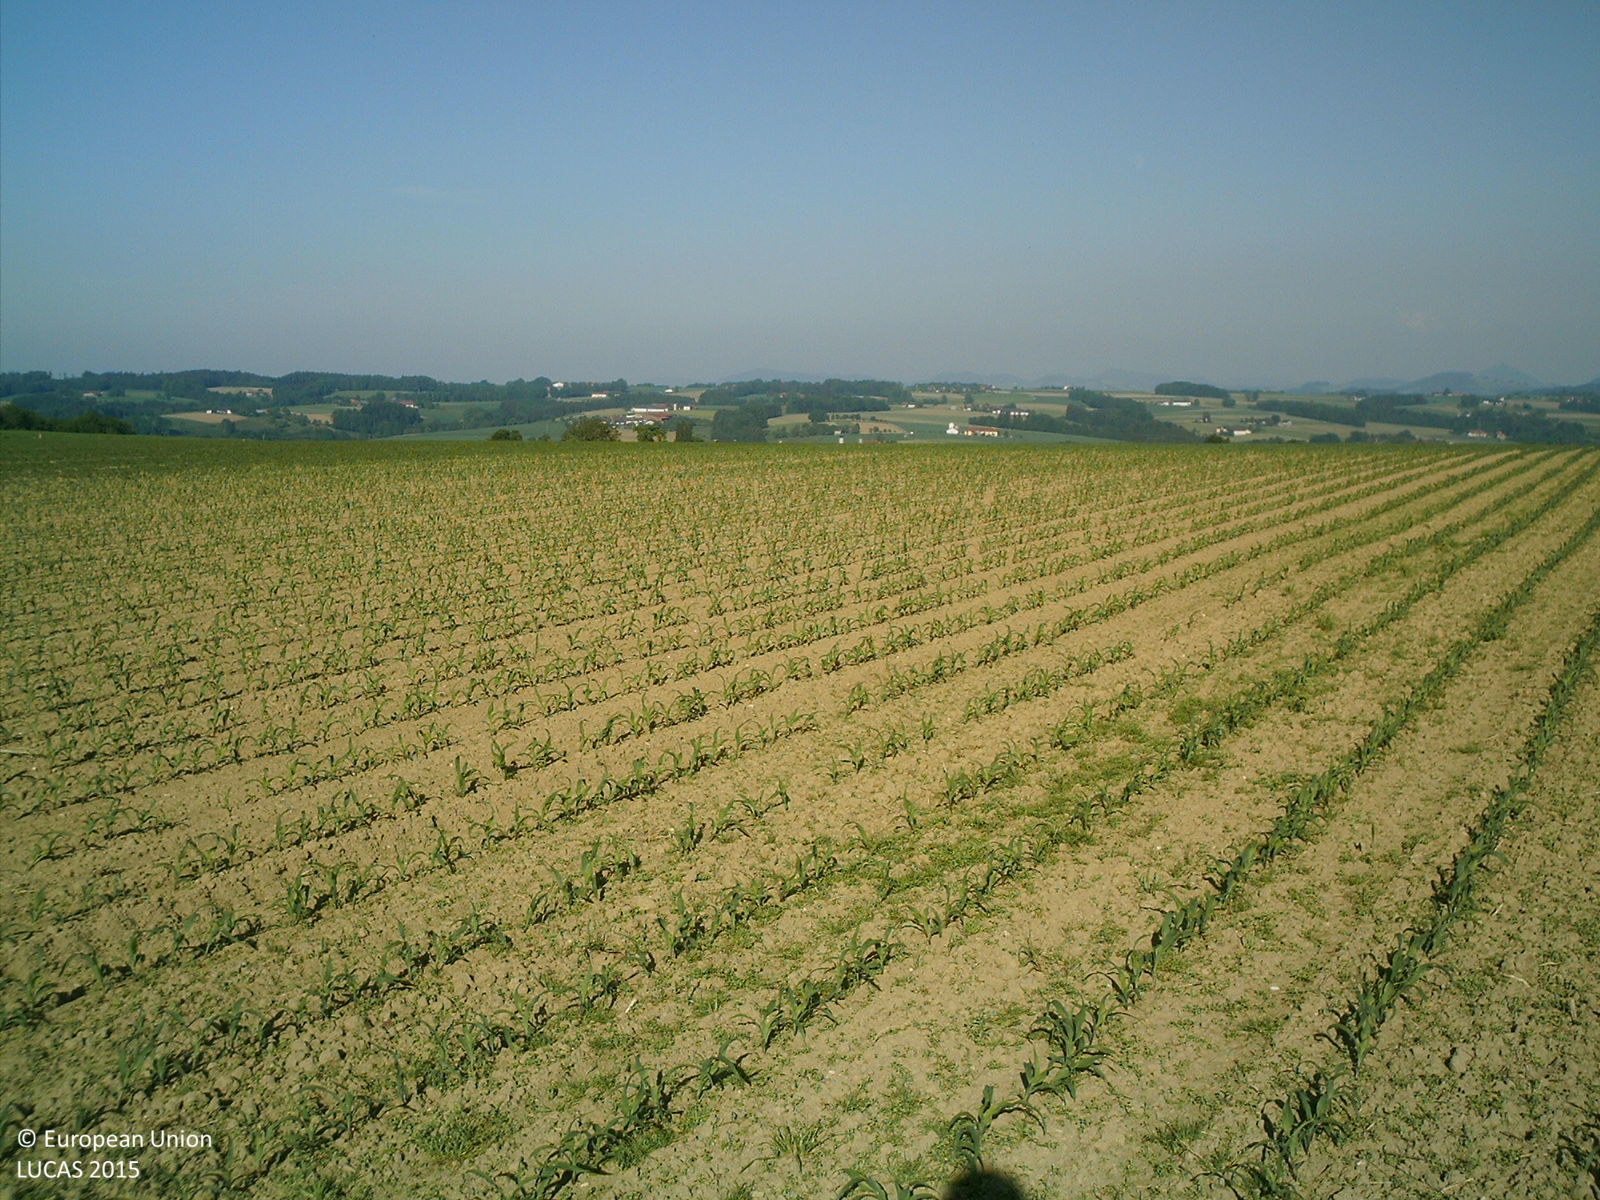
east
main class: Cropland
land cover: Maize
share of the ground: < 10 %
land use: Agriculture (excluding fallow land and kitchen gardens)
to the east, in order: Maize; Soya
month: May
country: AT
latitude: 48.0036
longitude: 14.0876
